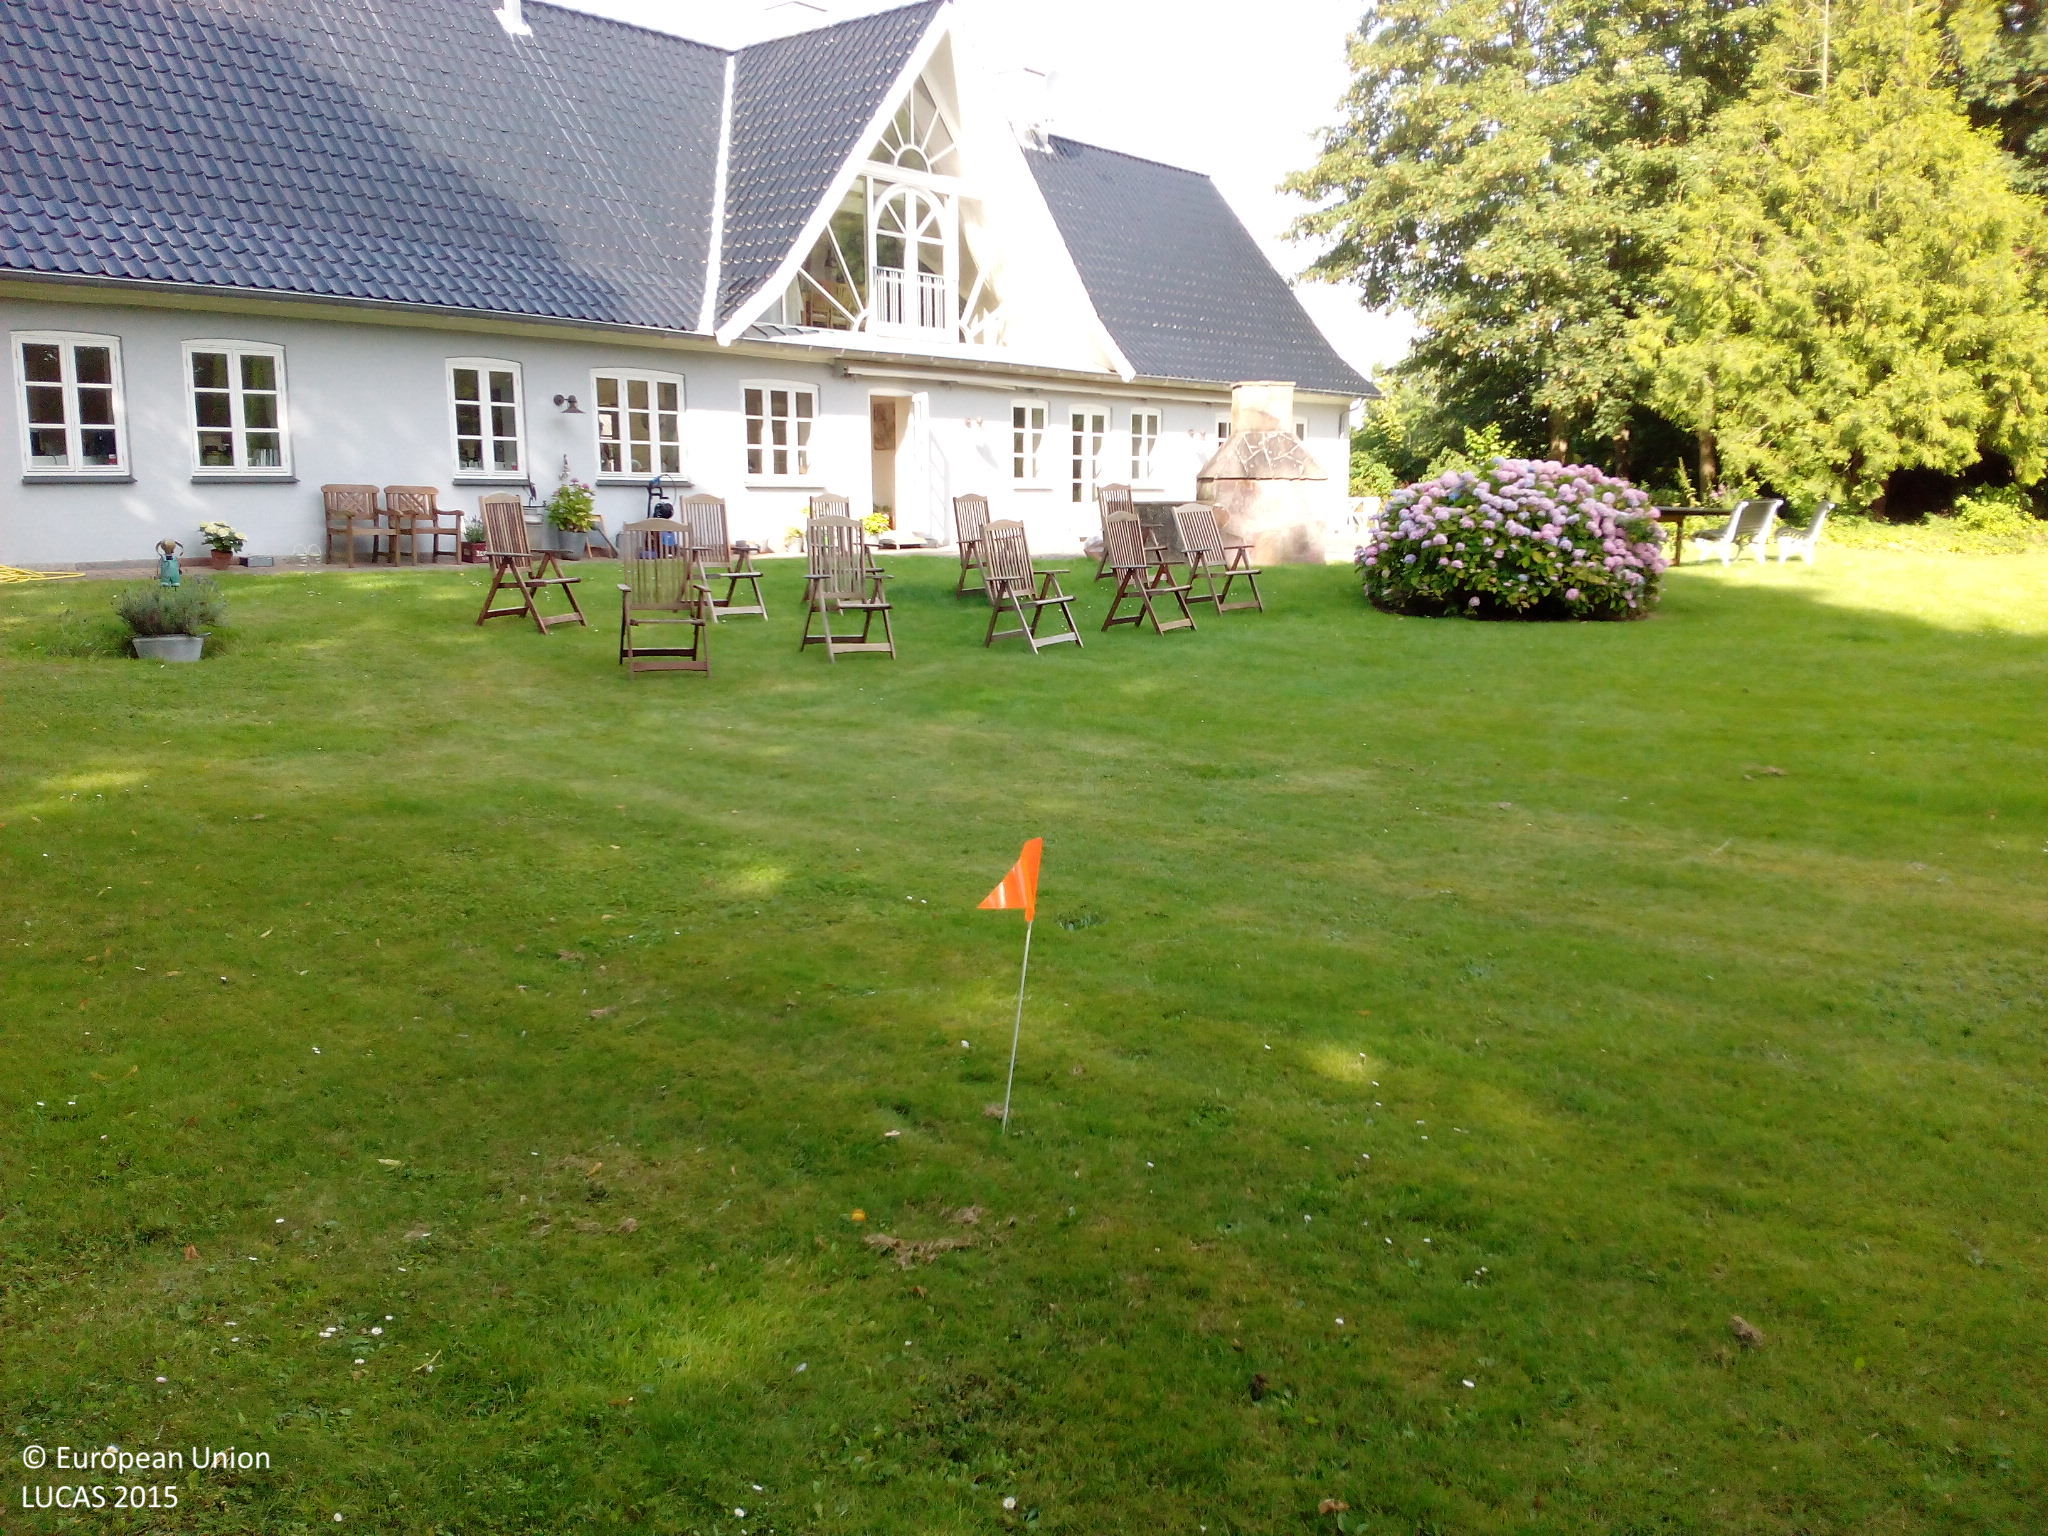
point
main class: Grassland
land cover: Grassland without tree/shrub cover
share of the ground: > 75 %
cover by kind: herbaceous plants 100 %
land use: Residential
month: August
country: DK
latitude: 55.6125
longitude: 12.1415
